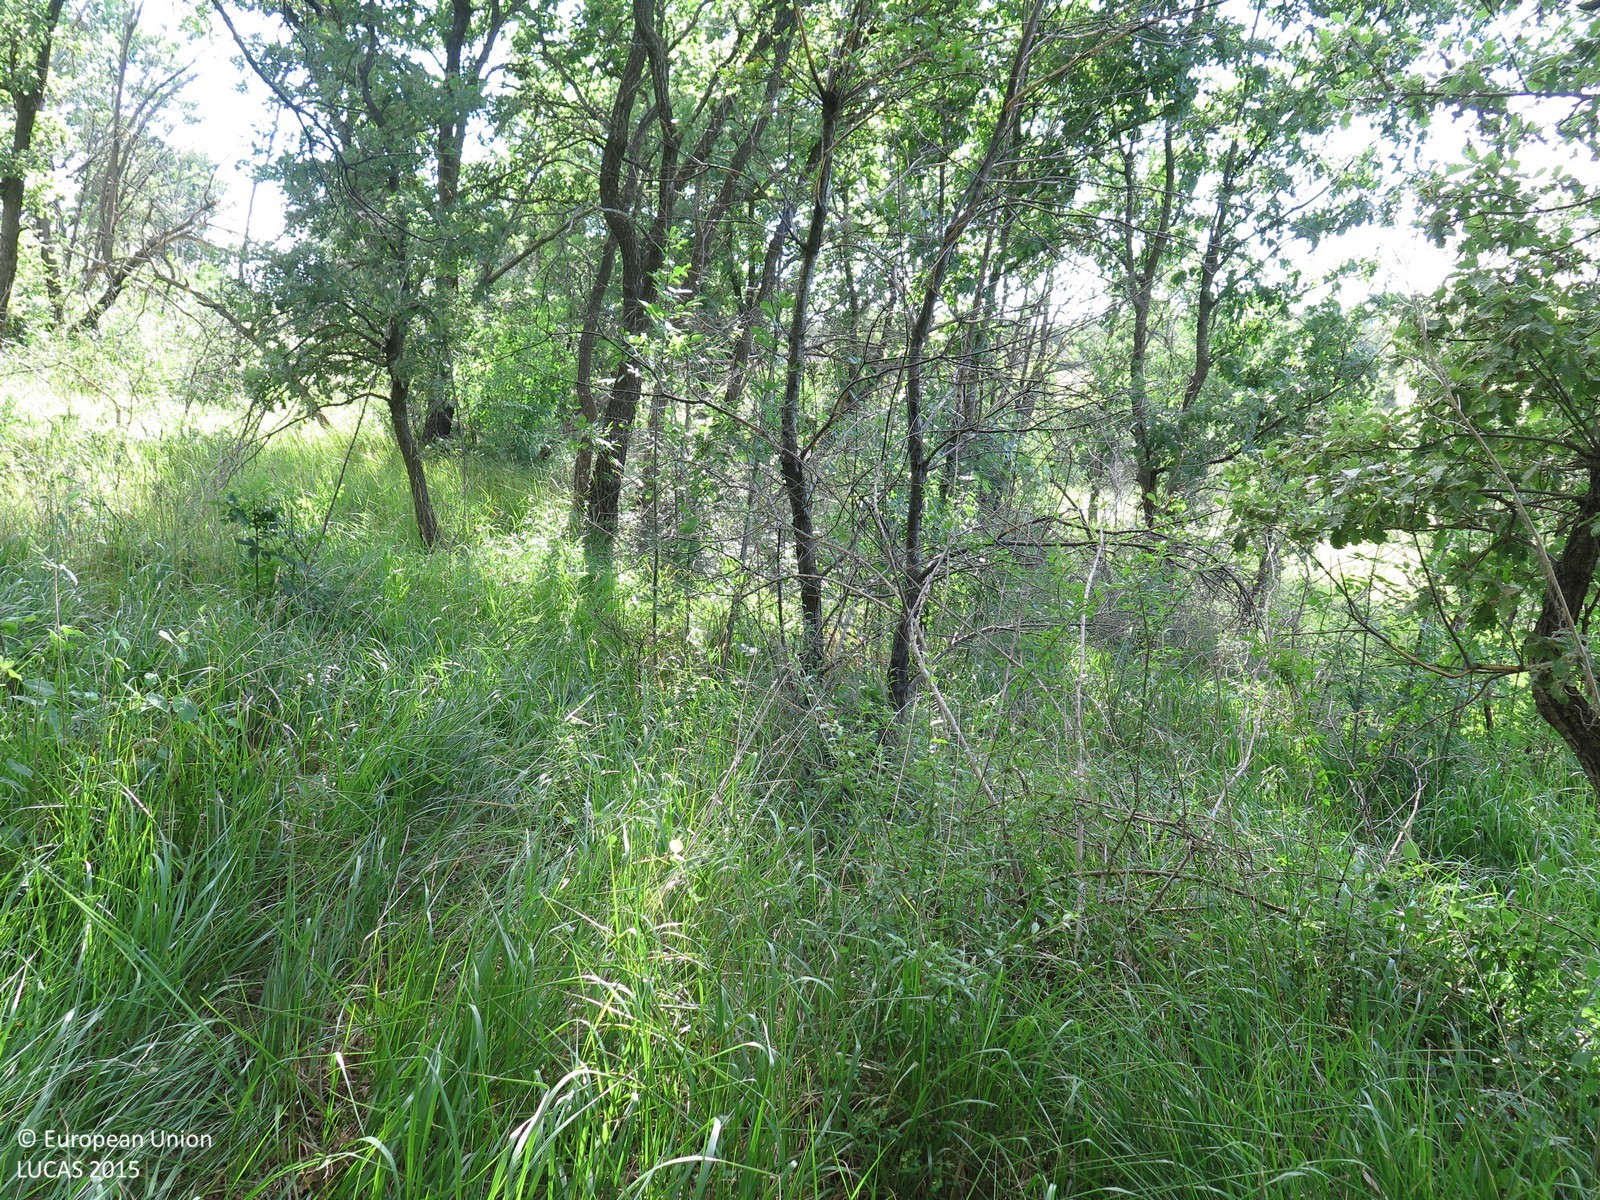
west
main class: Woodland
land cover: Broadleaved woodland
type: mesophytic deciduous forest
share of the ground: > 75 %
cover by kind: broadleaved forest trees 95 %, herbaceous plants 5 %
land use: Semi-natural and natural areas not in use
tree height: > 5 m
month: June
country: HR
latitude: 45.2024
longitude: 13.7758
